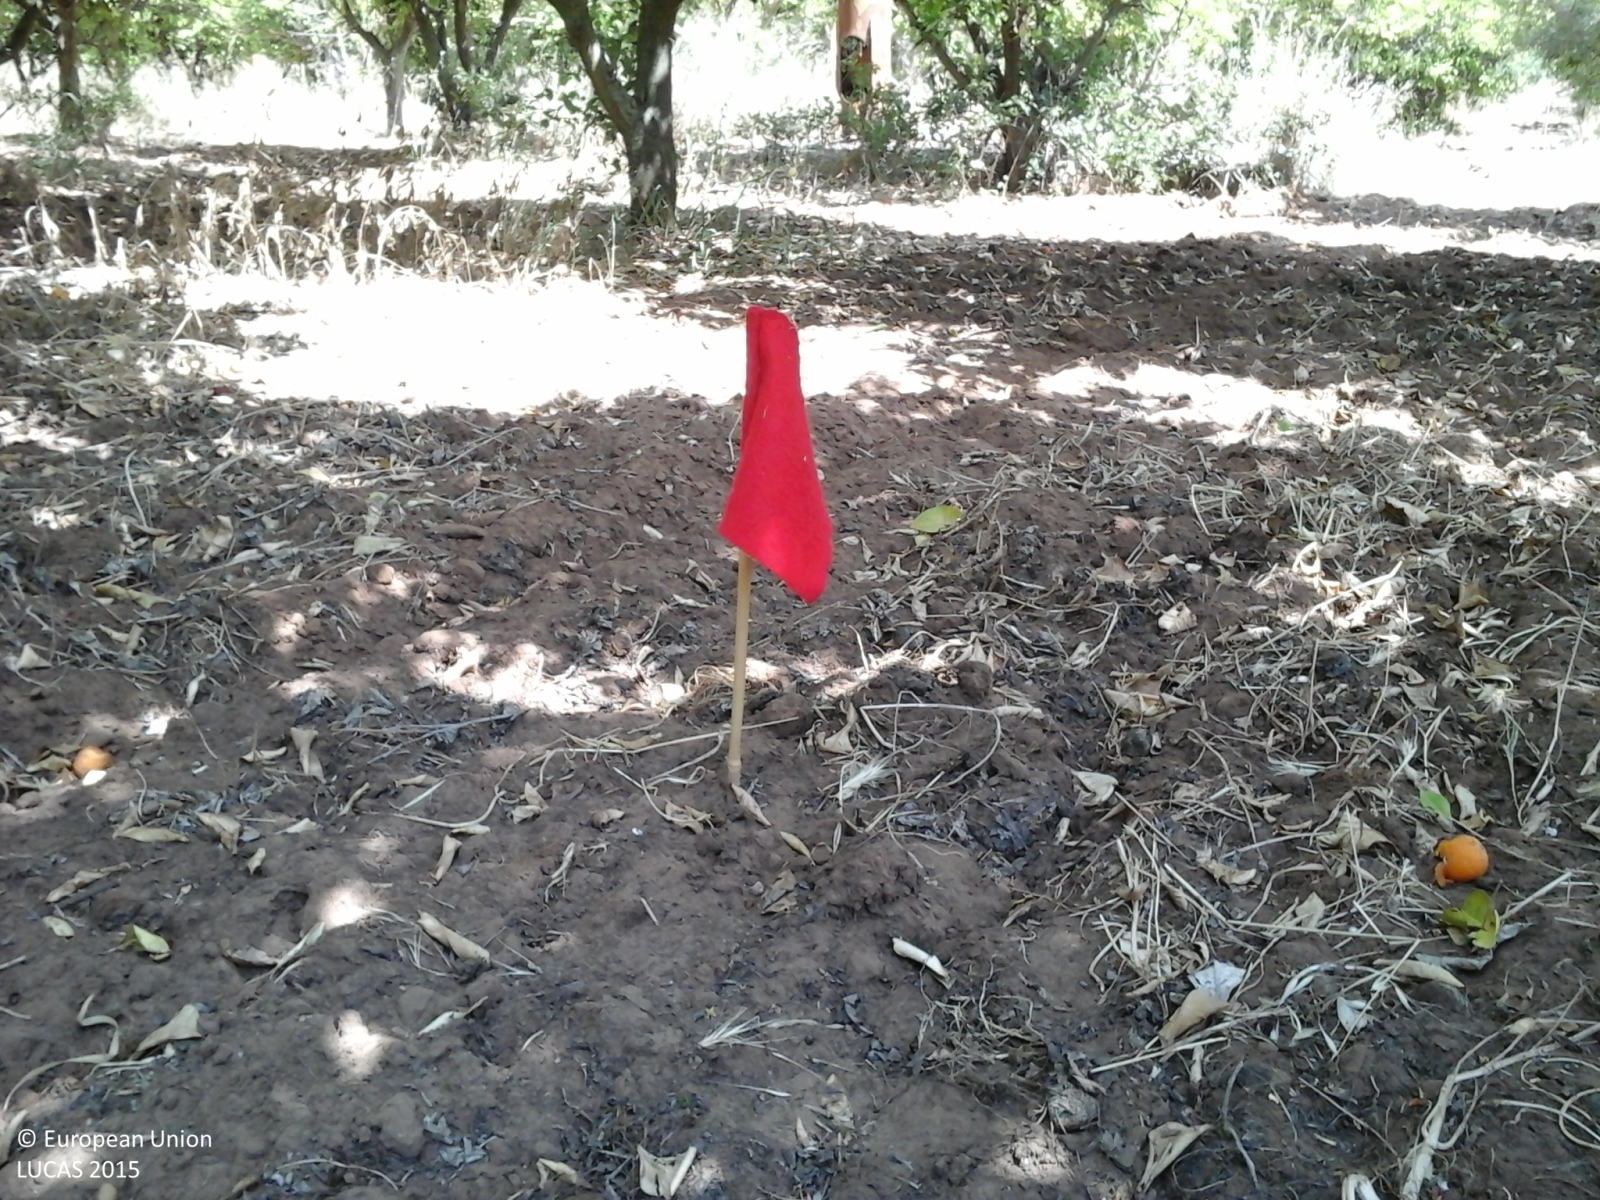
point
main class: Cropland
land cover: Other citrus fruit
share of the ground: > 75 %
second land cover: Spontaneously vegetated surfaces
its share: > 75 %
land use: Agriculture (excluding fallow land and kitchen gardens)
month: May
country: IT
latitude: 37.1467
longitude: 14.5695
